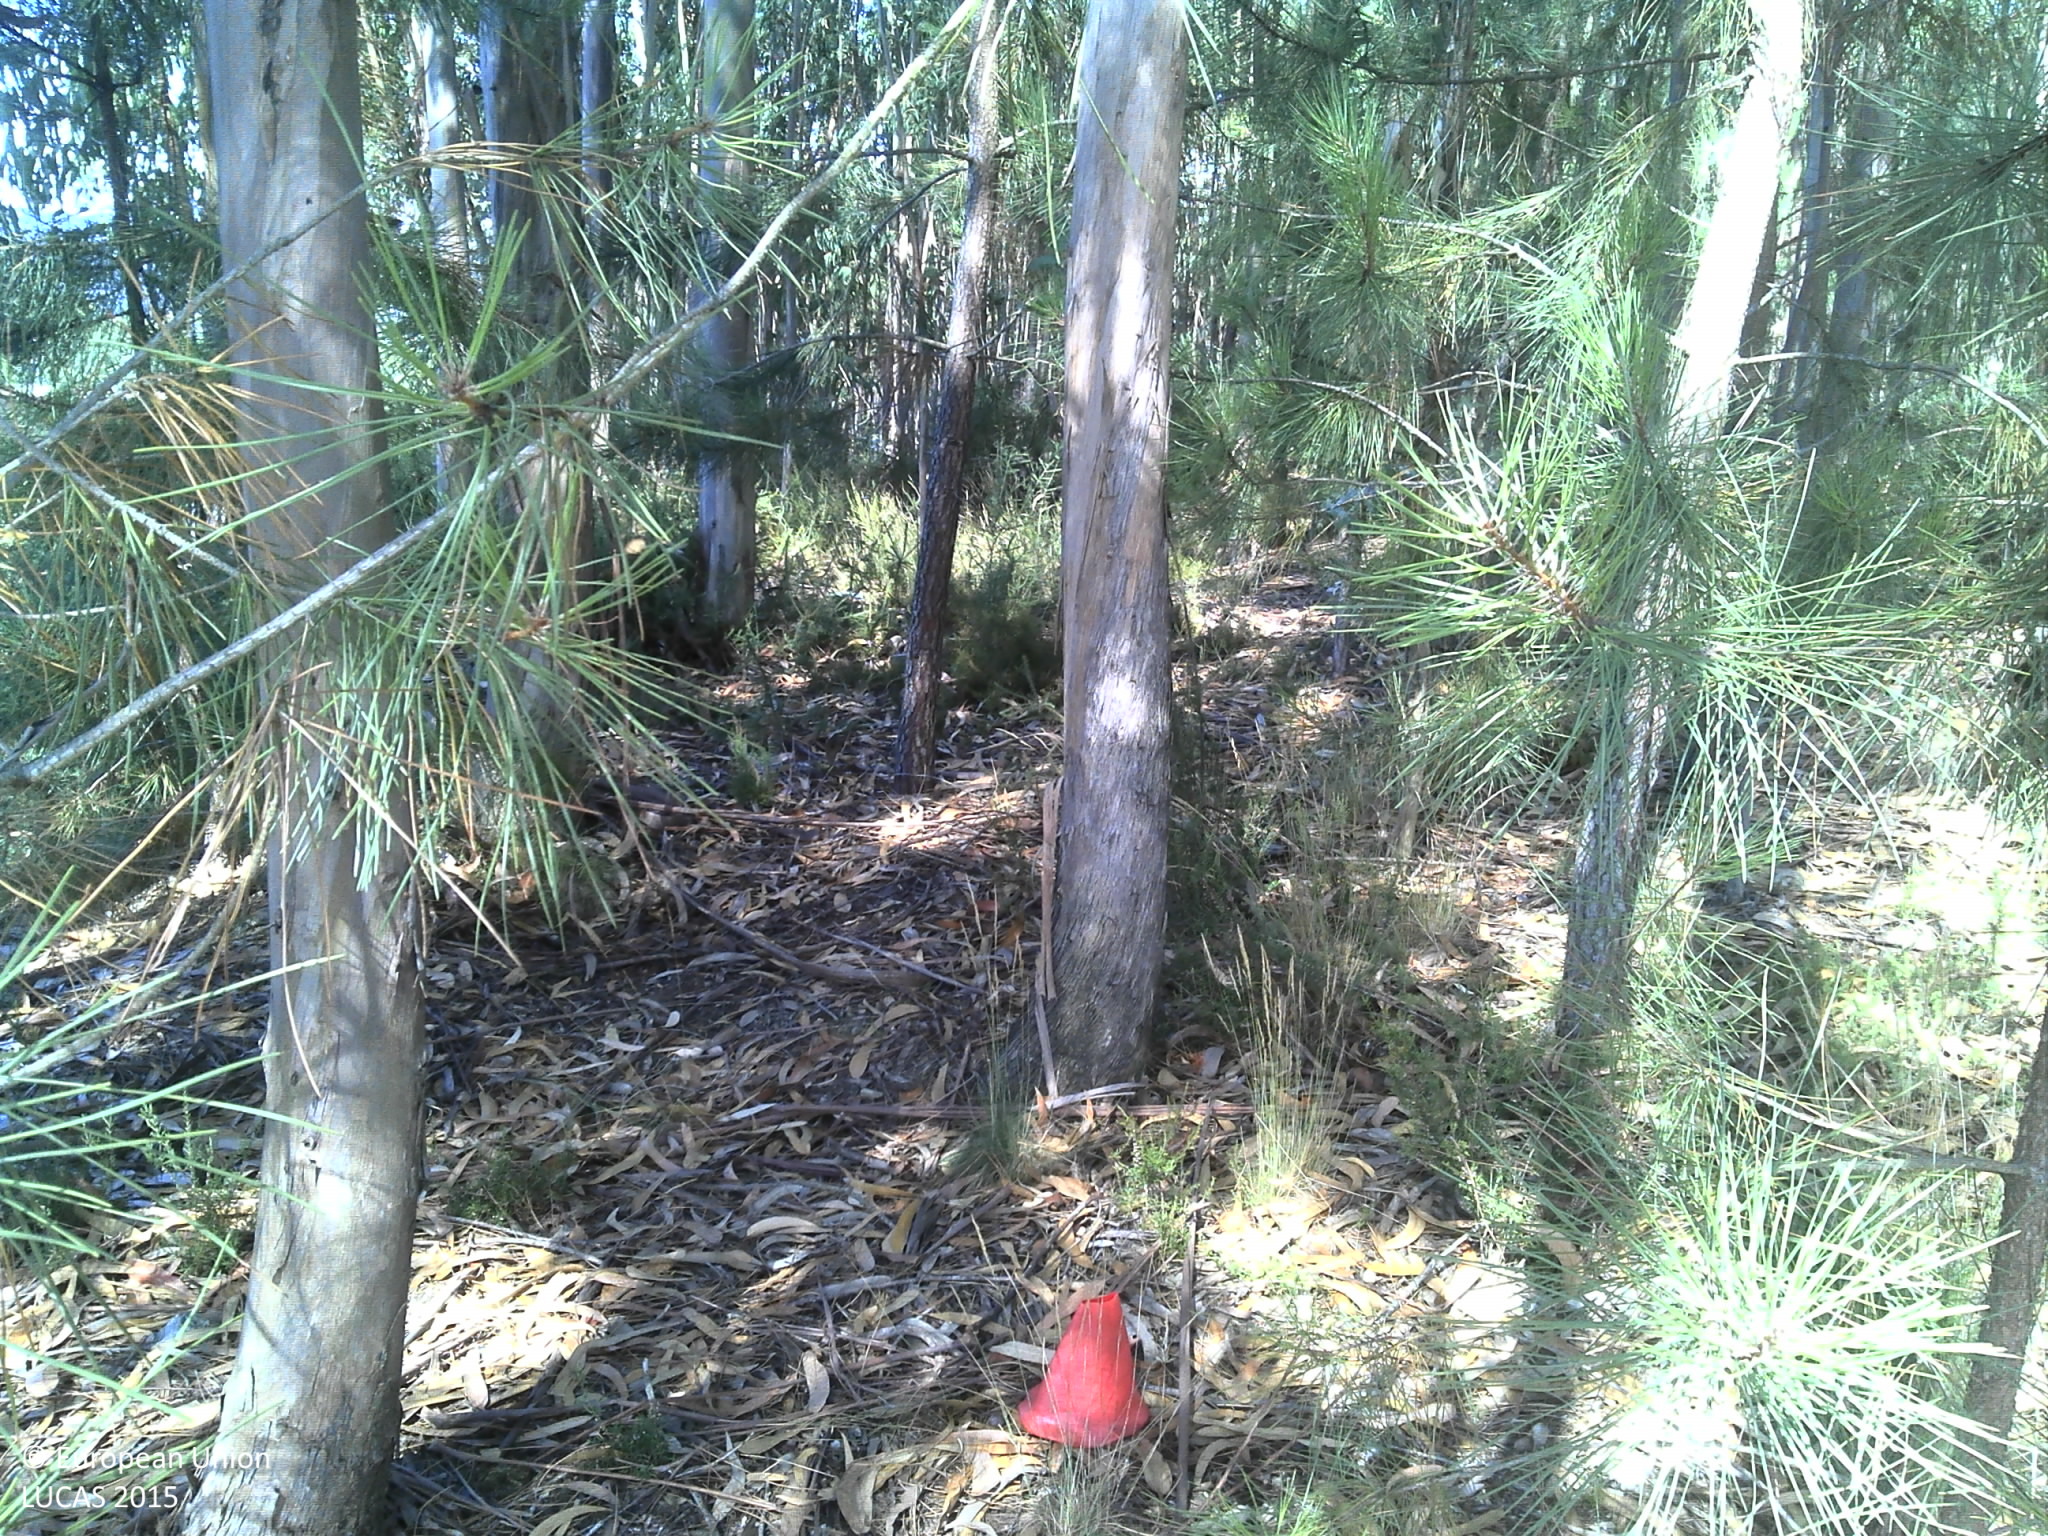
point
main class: Woodland
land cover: Broadleaved woodland
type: exotic forest
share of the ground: 50 - 75 %
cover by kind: broadleaved forest trees 70 %, unconsolidated bare surface 20 %, coniferous forest trees 5 %, shrubs 5 %
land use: Forestry
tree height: > 5 m
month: July
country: PT
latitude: 41.0424
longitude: -8.4053
